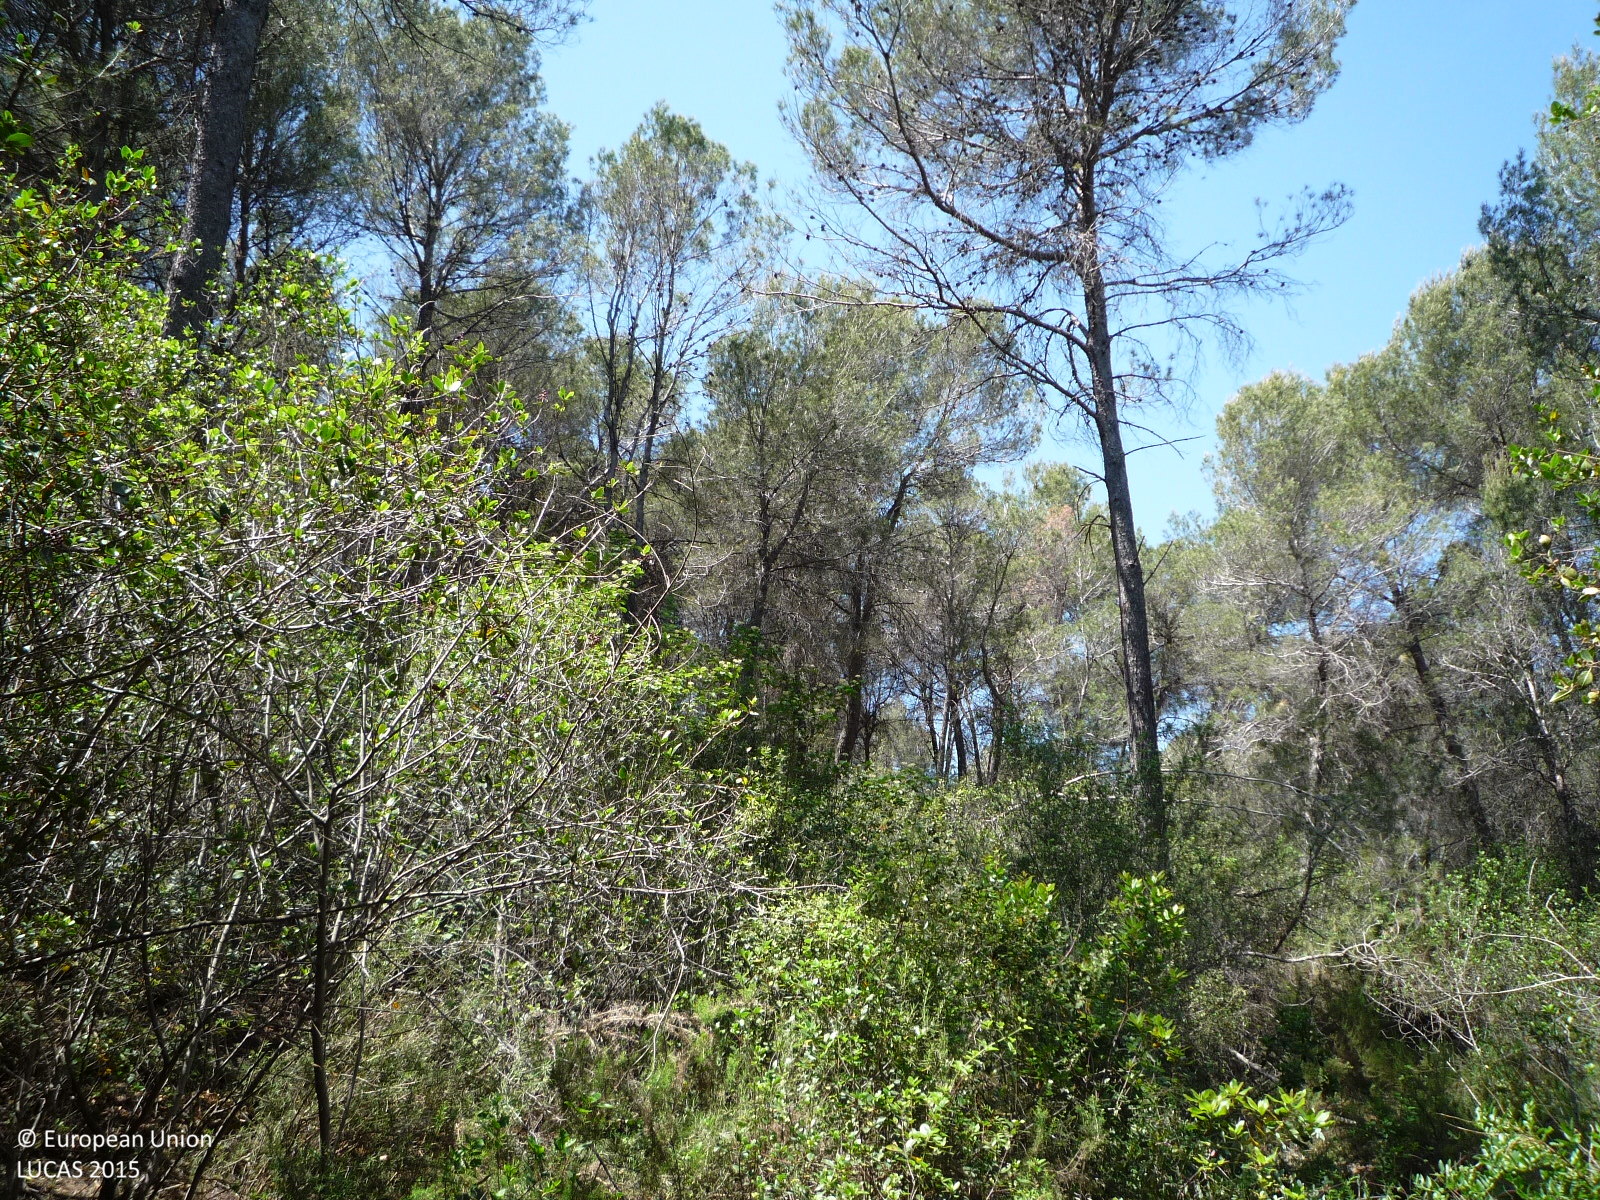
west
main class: Woodland
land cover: Pine dominated mixed woodland
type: coniferous forest of the mediterranean region
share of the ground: > 75 %
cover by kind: coniferous forest trees 75 %, broadleaved forest trees 25 %
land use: Semi-natural and natural areas not in use
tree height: > 5 m
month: May
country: ES
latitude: 41.5084
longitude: 2.0737
